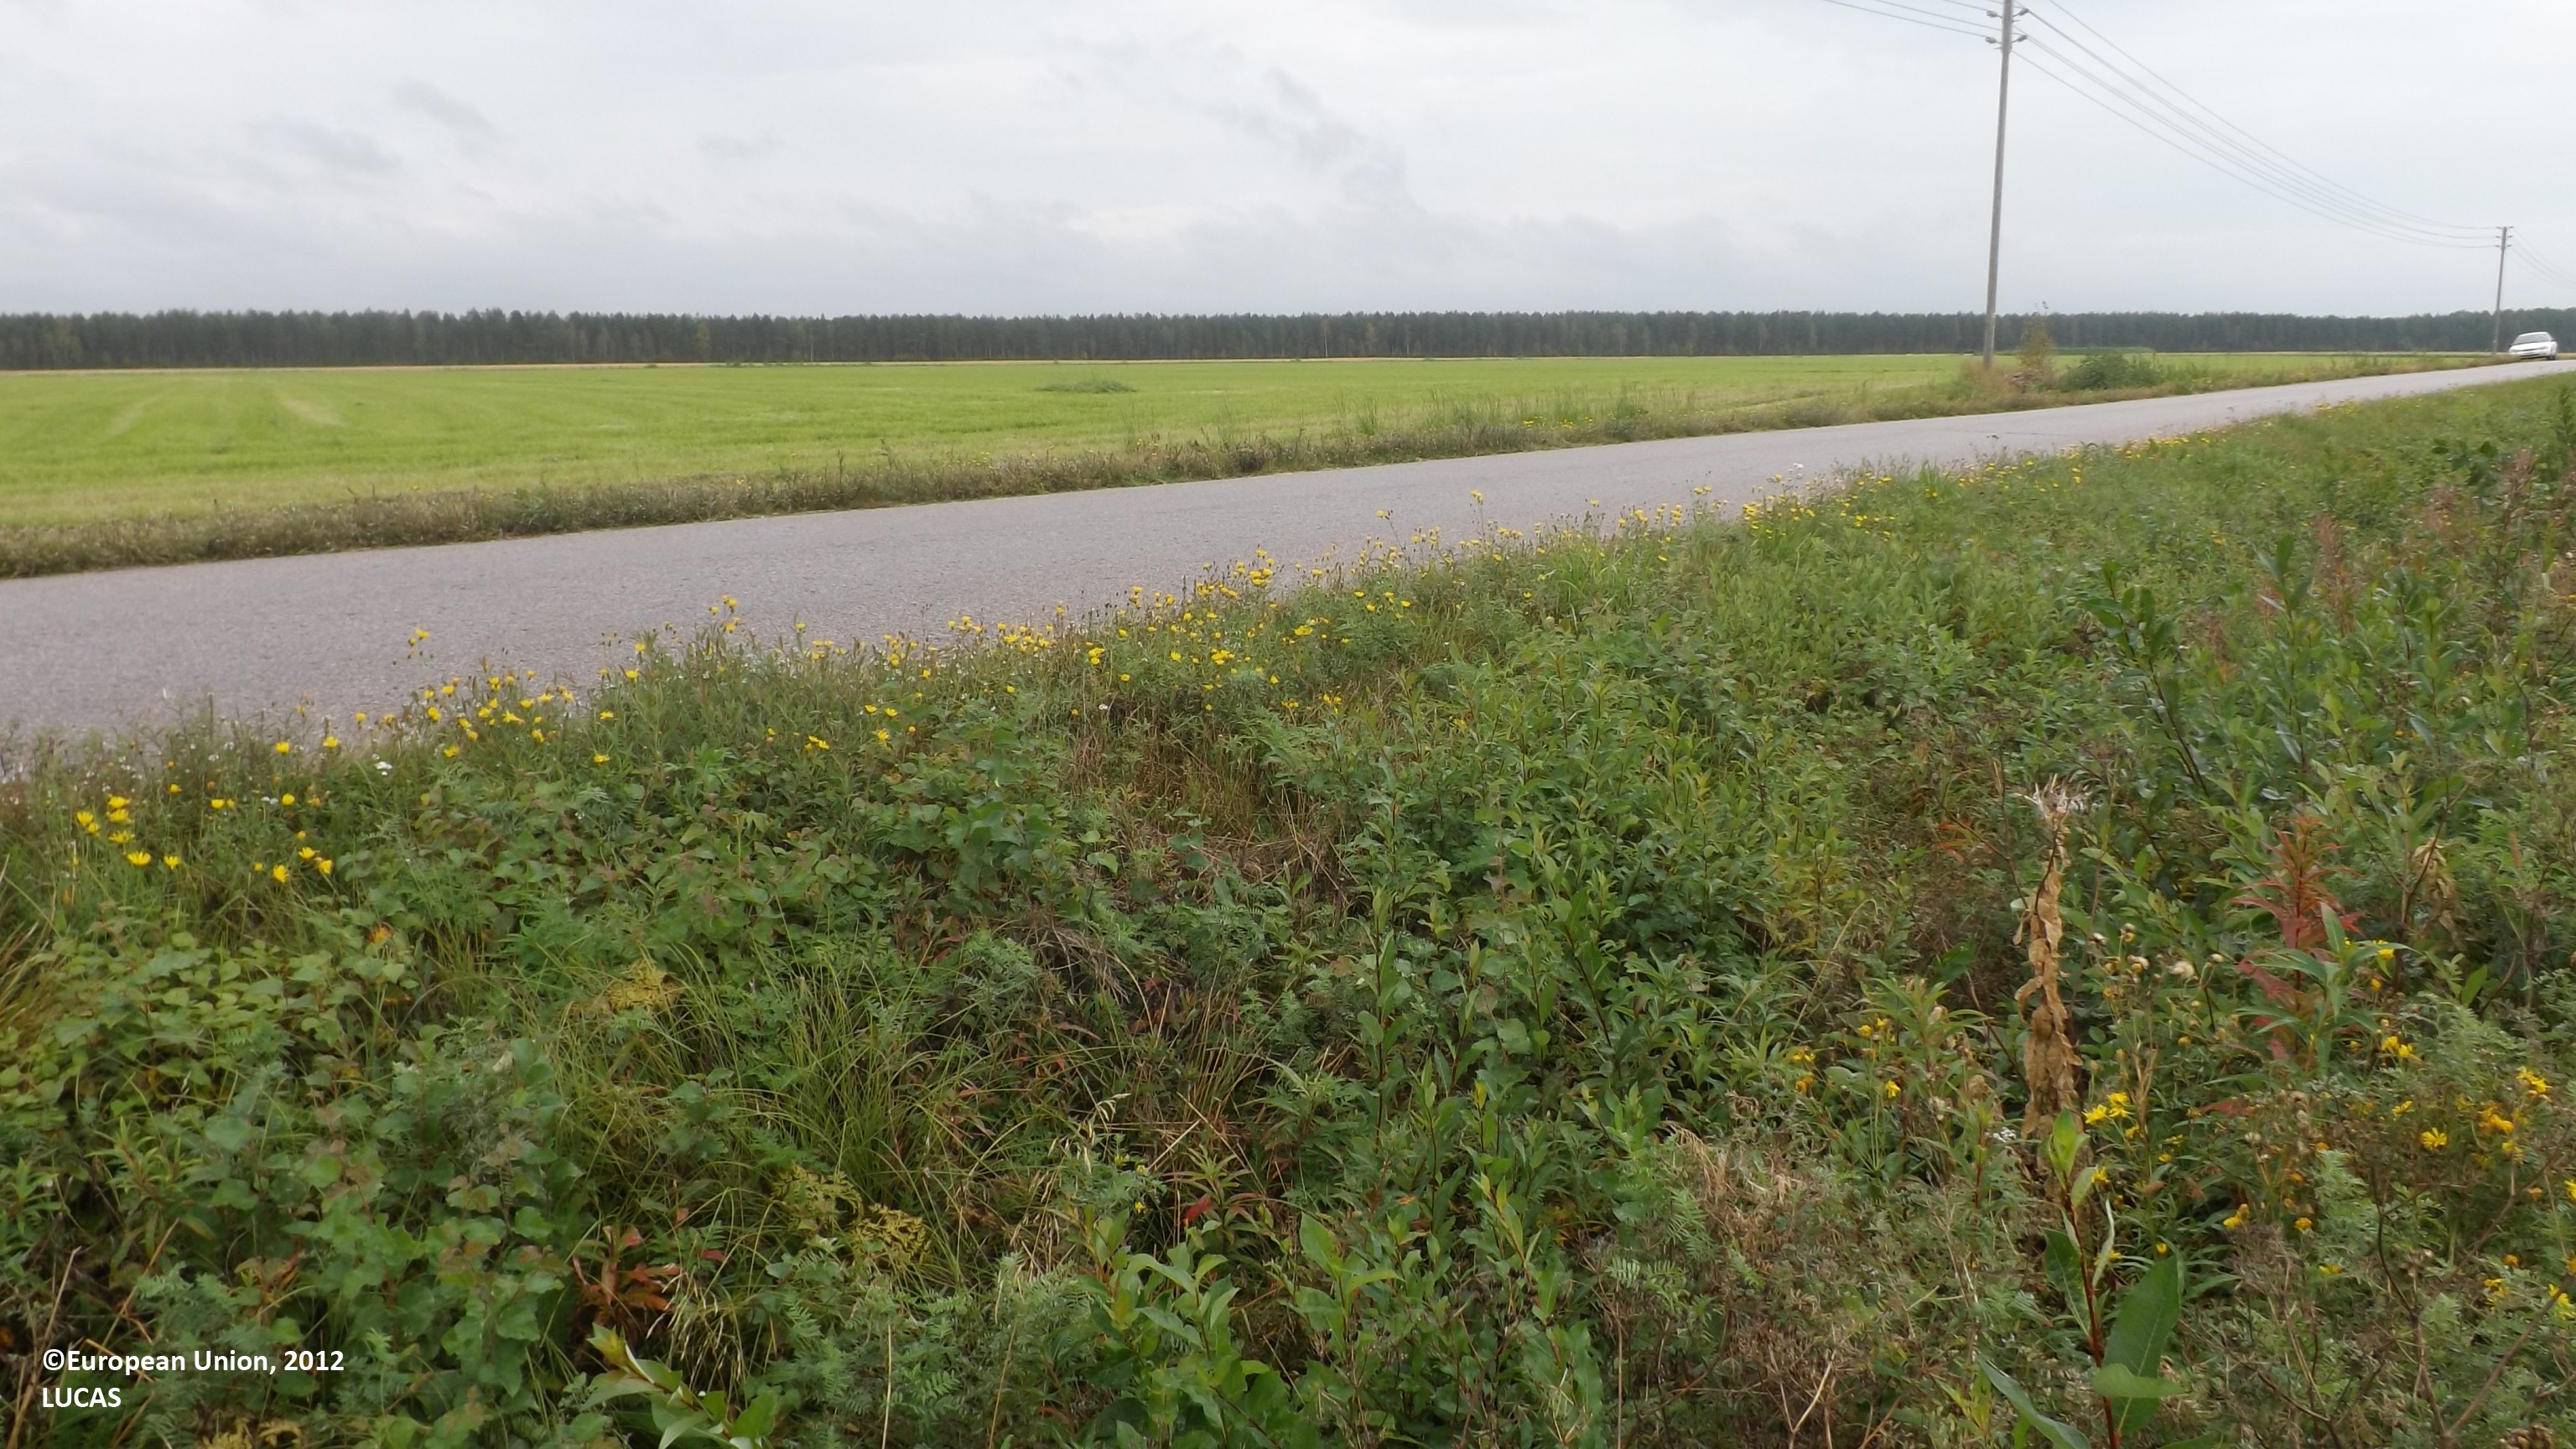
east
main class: Cropland
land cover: Potatoes
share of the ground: > 75 %
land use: Agriculture (excluding fallow land and kitchen gardens)
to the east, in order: Potatoes; Grass margins; Ditches and canals; Grass margins; Paved roads, cycling and walking lanes; Grass margins; Ditches and canals; Electric lines; Temporary grasslands
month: August
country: FI
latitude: 63.8827
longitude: 24.0139
